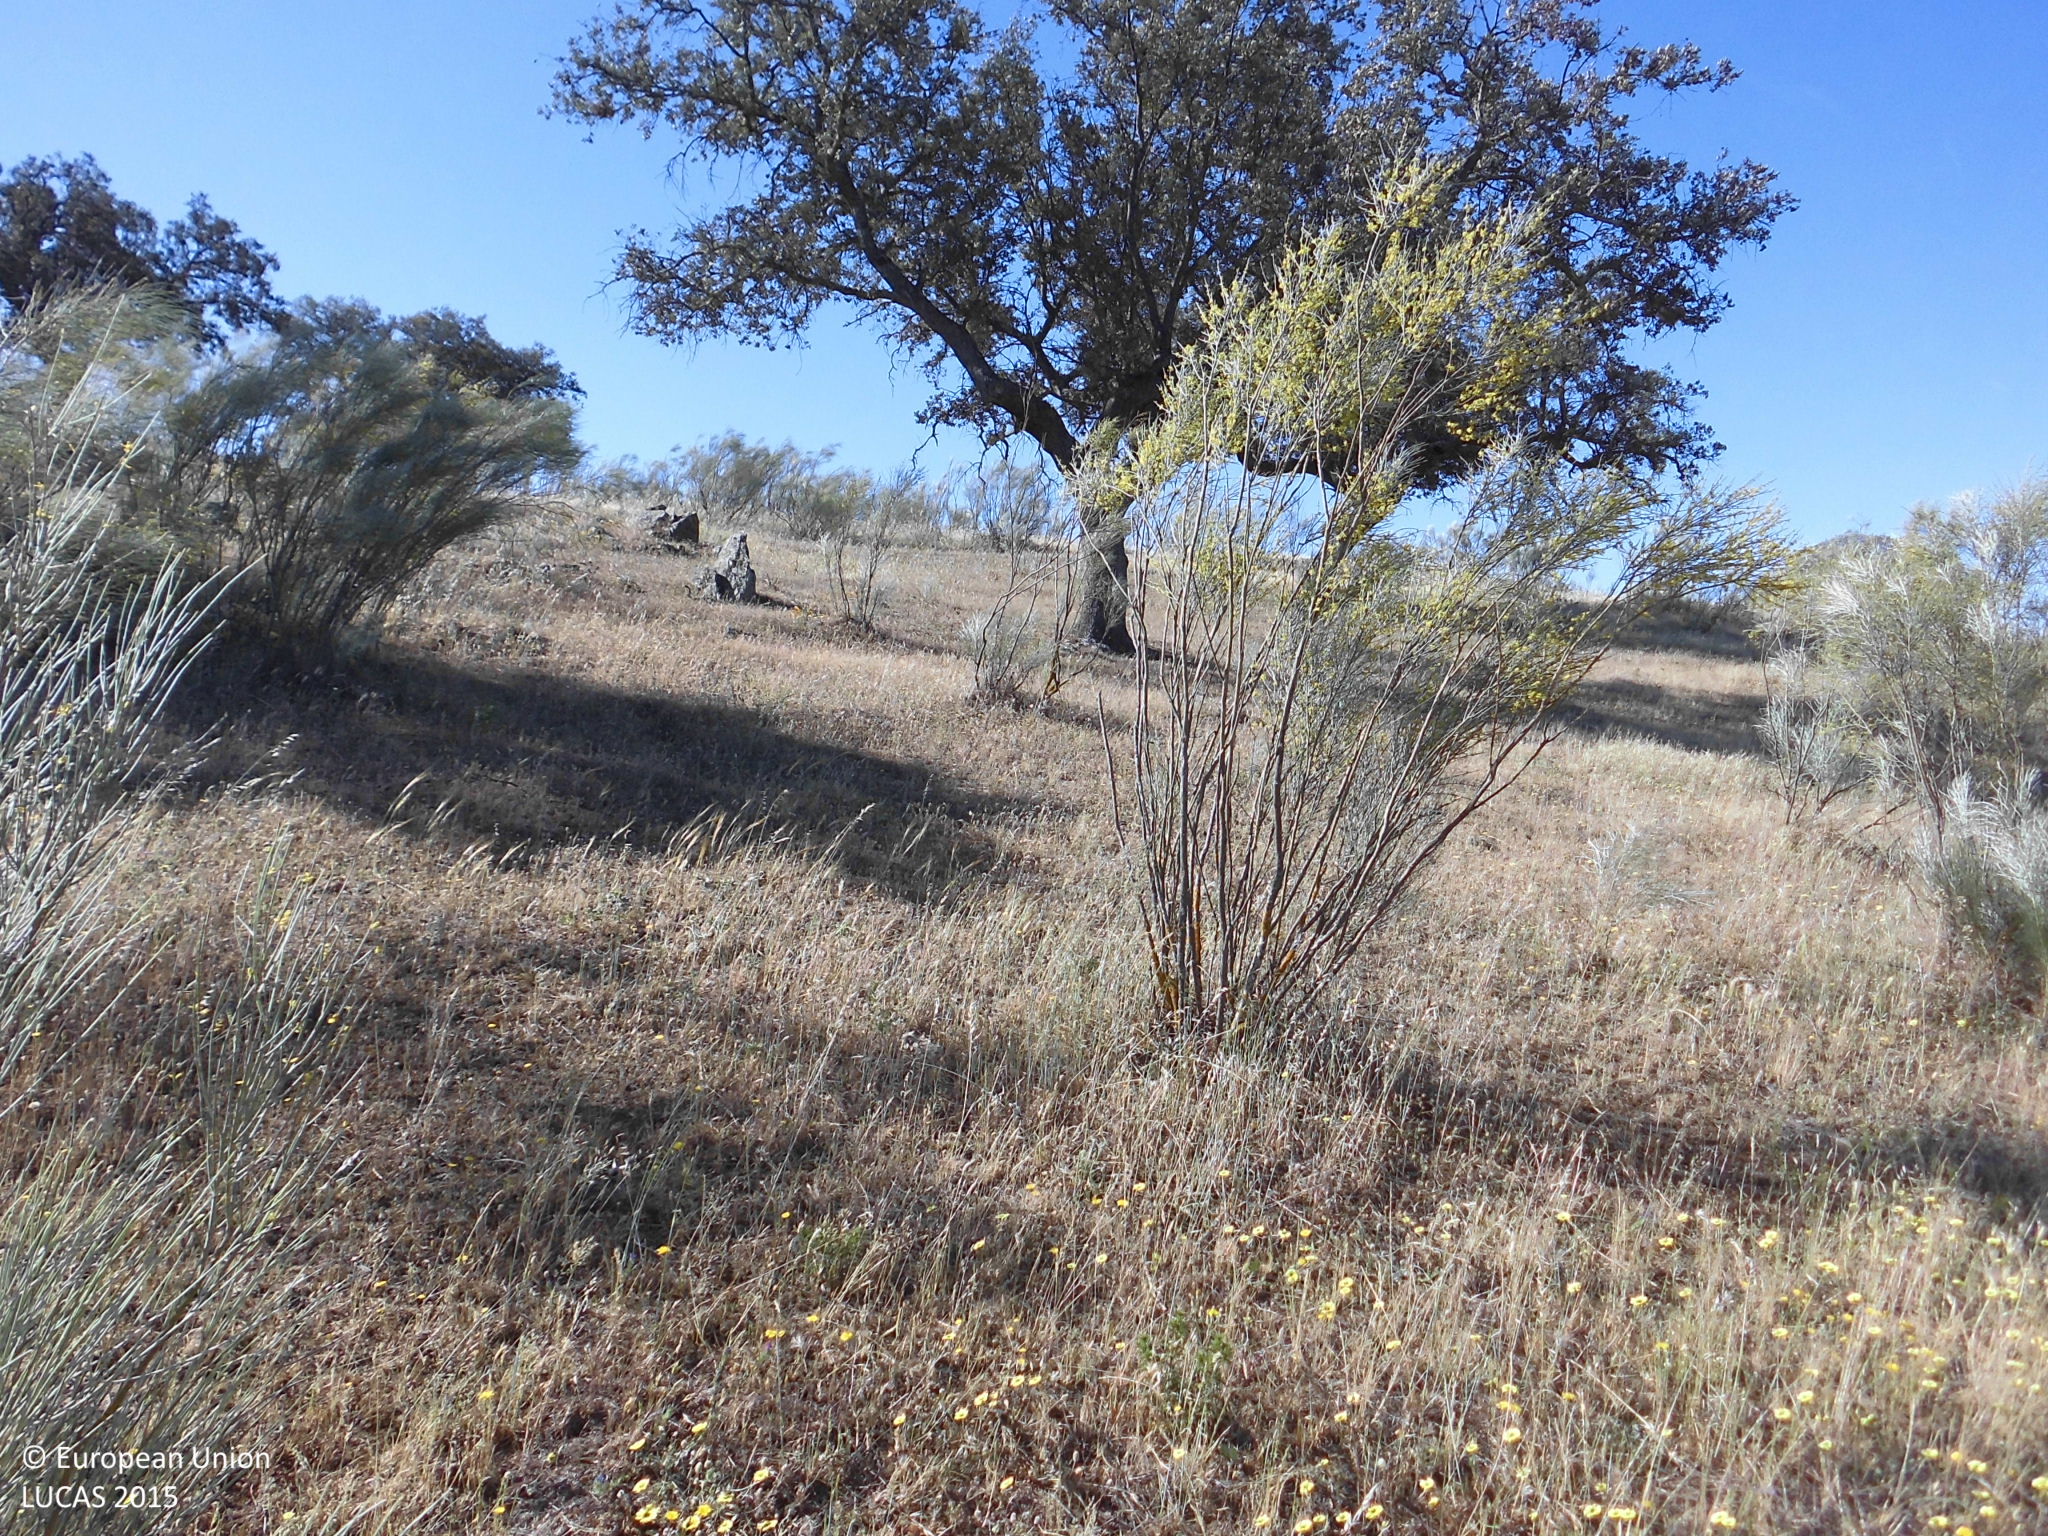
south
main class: Woodland
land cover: Broadleaved woodland
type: broadleaved evergreen forest
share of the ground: 10 - 25 %
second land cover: Grassland without tree/shrub cover
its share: > 75 %
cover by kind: herbaceous plants 65 %, broadleaved forest trees 25 %, shrubs 10 %
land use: Forestry
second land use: Agriculture (excluding fallow land and kitchen gardens)
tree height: > 5 m
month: May
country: ES
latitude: 39.5164
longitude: -6.9587
